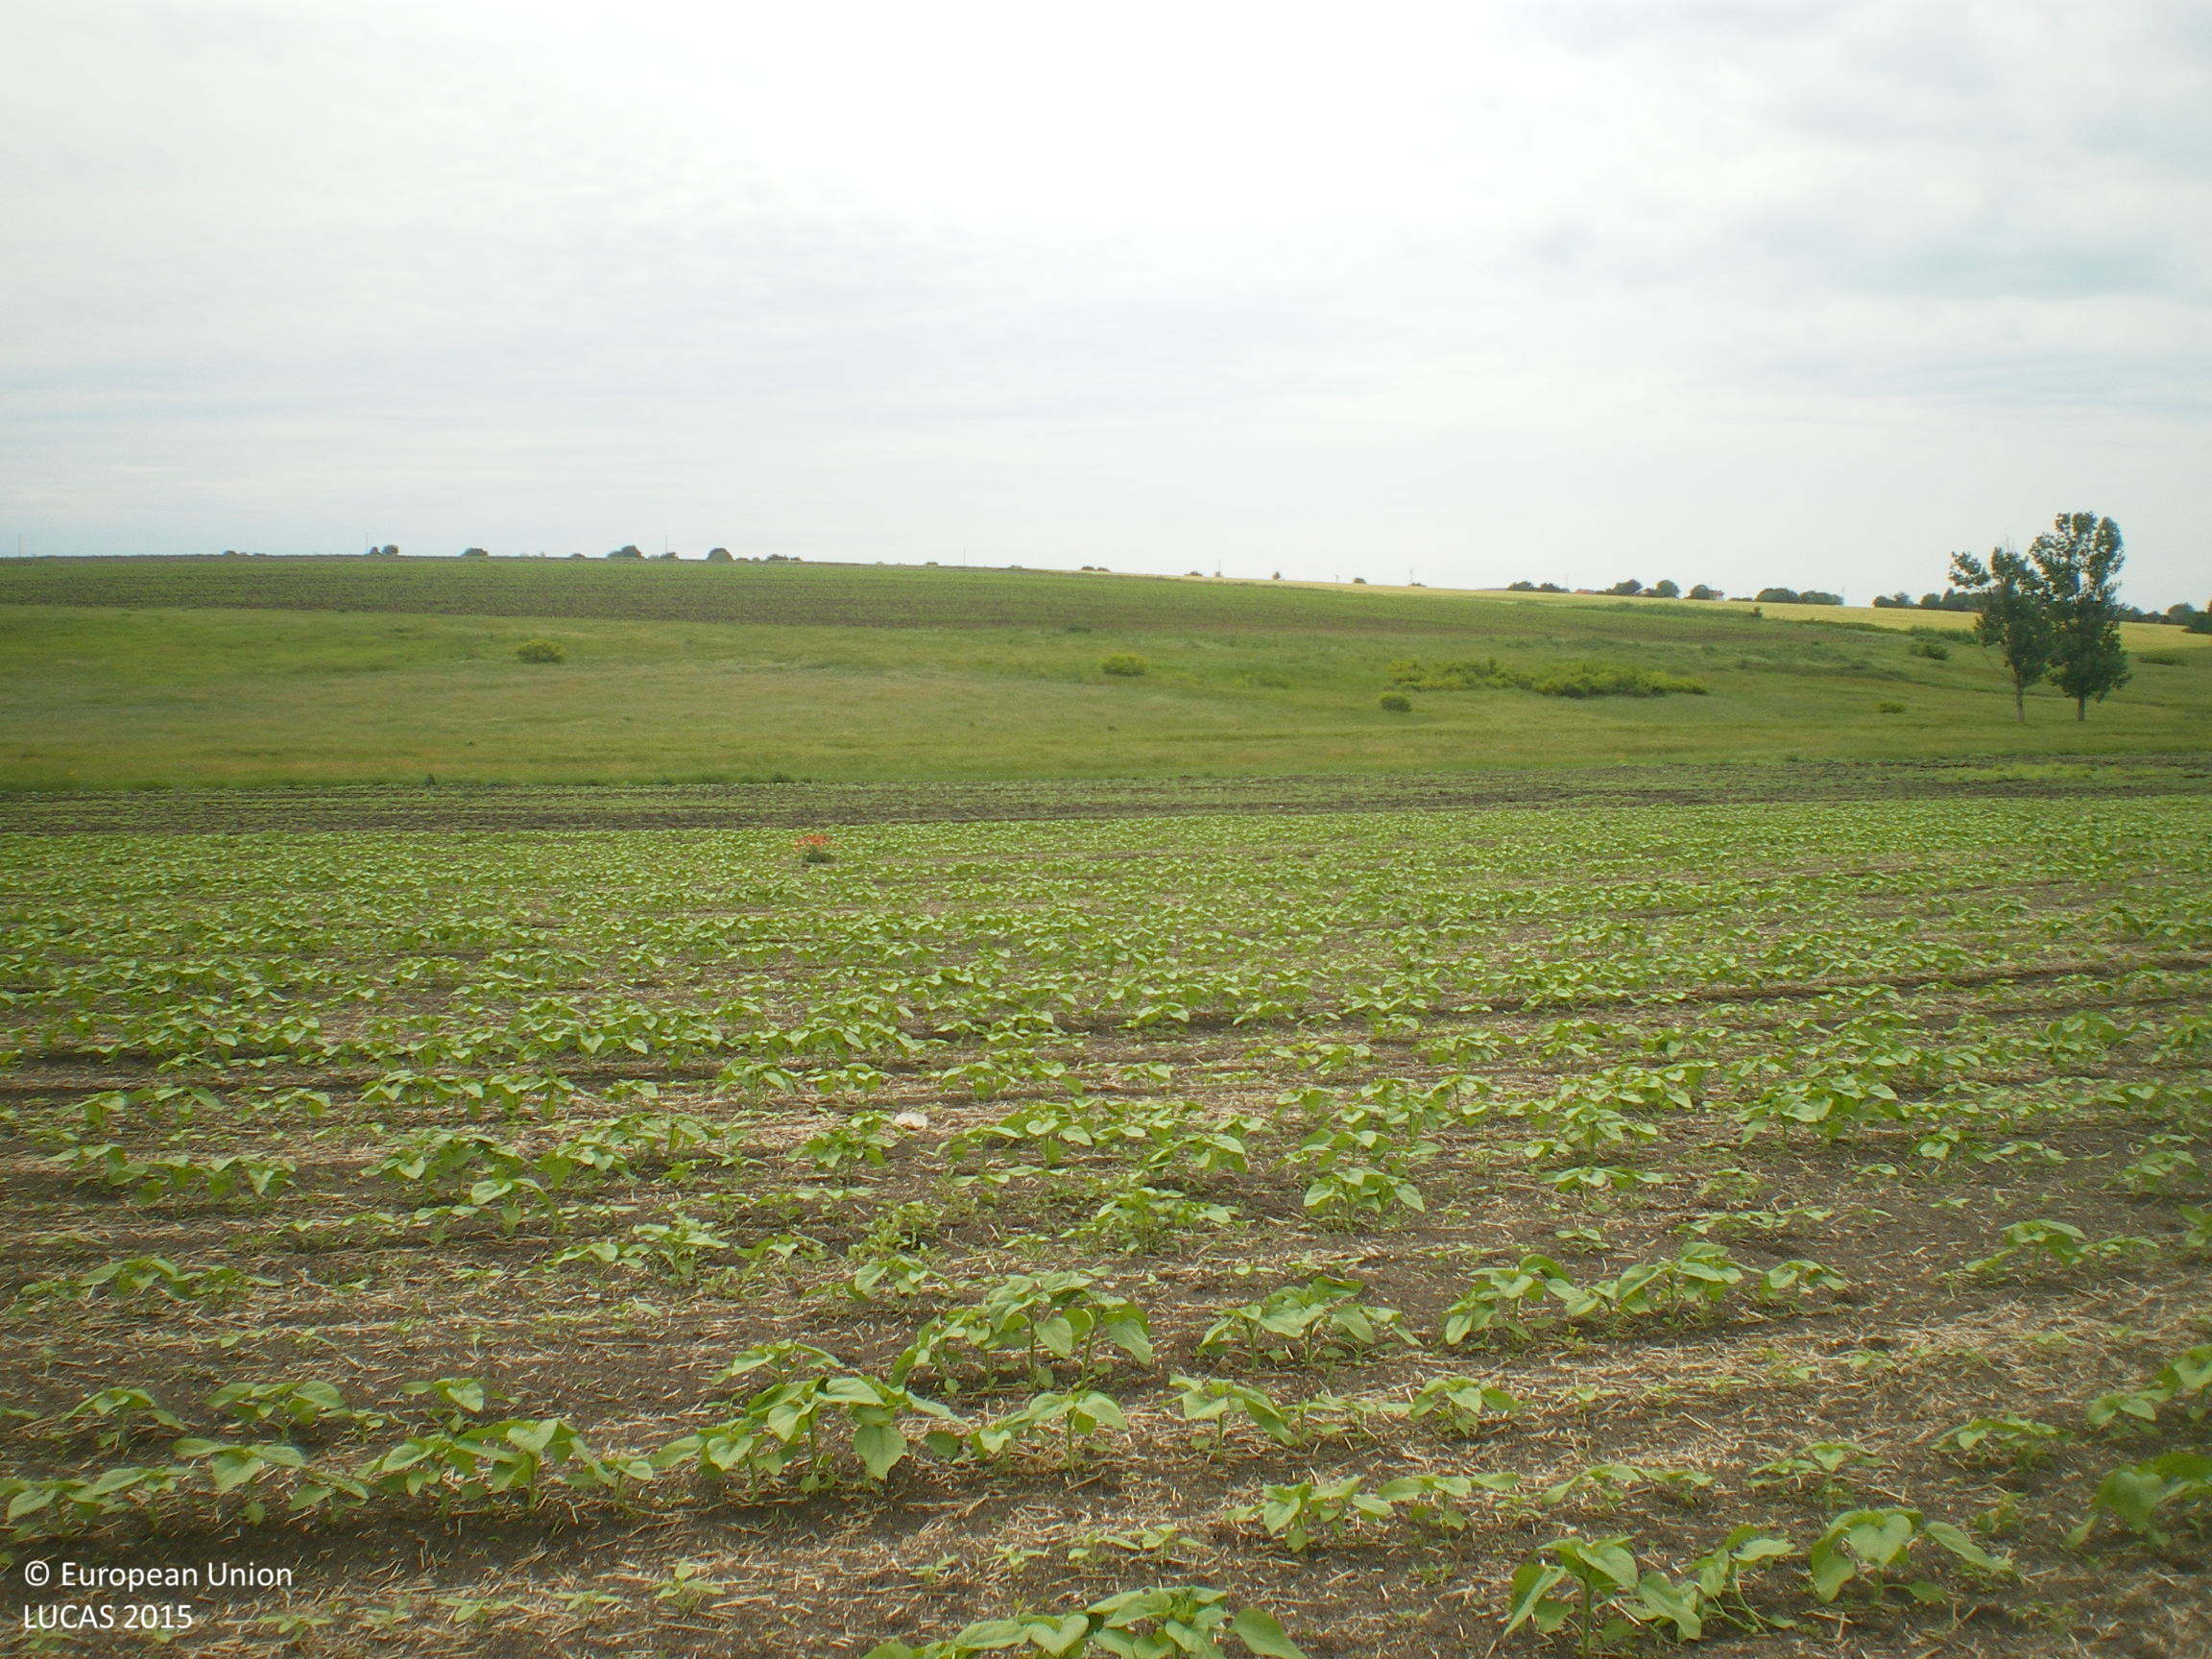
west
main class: Cropland
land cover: Sunflower
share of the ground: 10 - 25 %
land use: Agriculture (excluding fallow land and kitchen gardens)
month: May
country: BG
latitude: 42.2323
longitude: 25.4421
